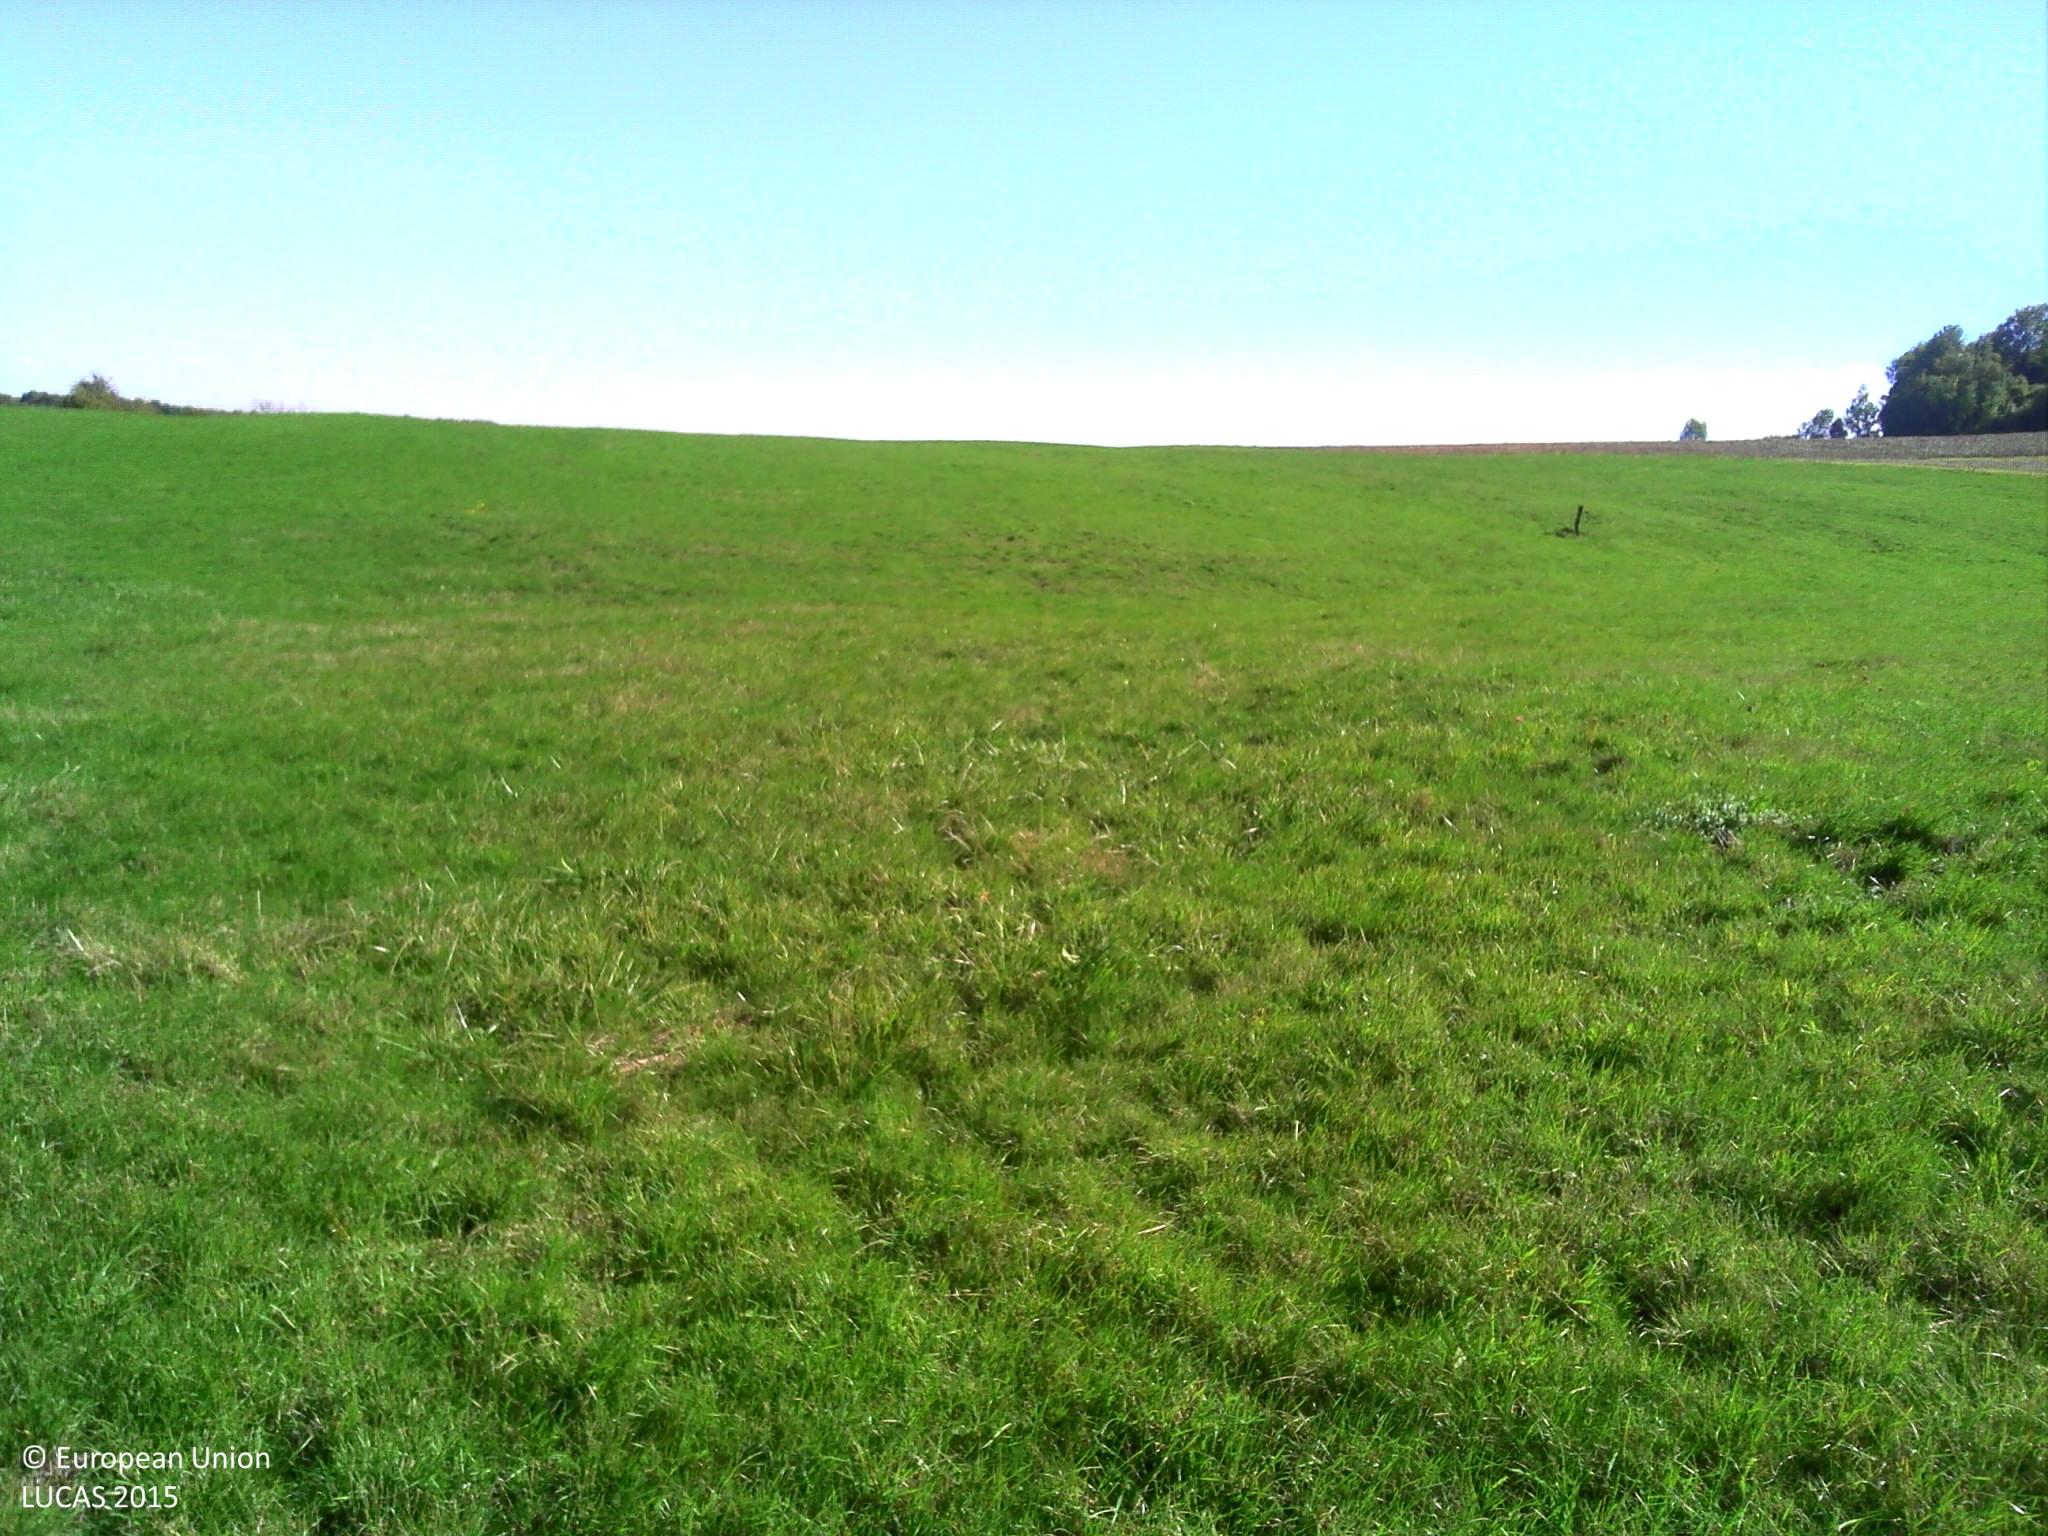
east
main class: Cropland
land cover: Temporary grasslands
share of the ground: > 75 %
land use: Agriculture (excluding fallow land and kitchen gardens)
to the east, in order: Temporary grasslands; Abandoned hedges; Grass margins; Rape and turnip rape
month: September
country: FR
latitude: 48.5115
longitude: 6.0066
